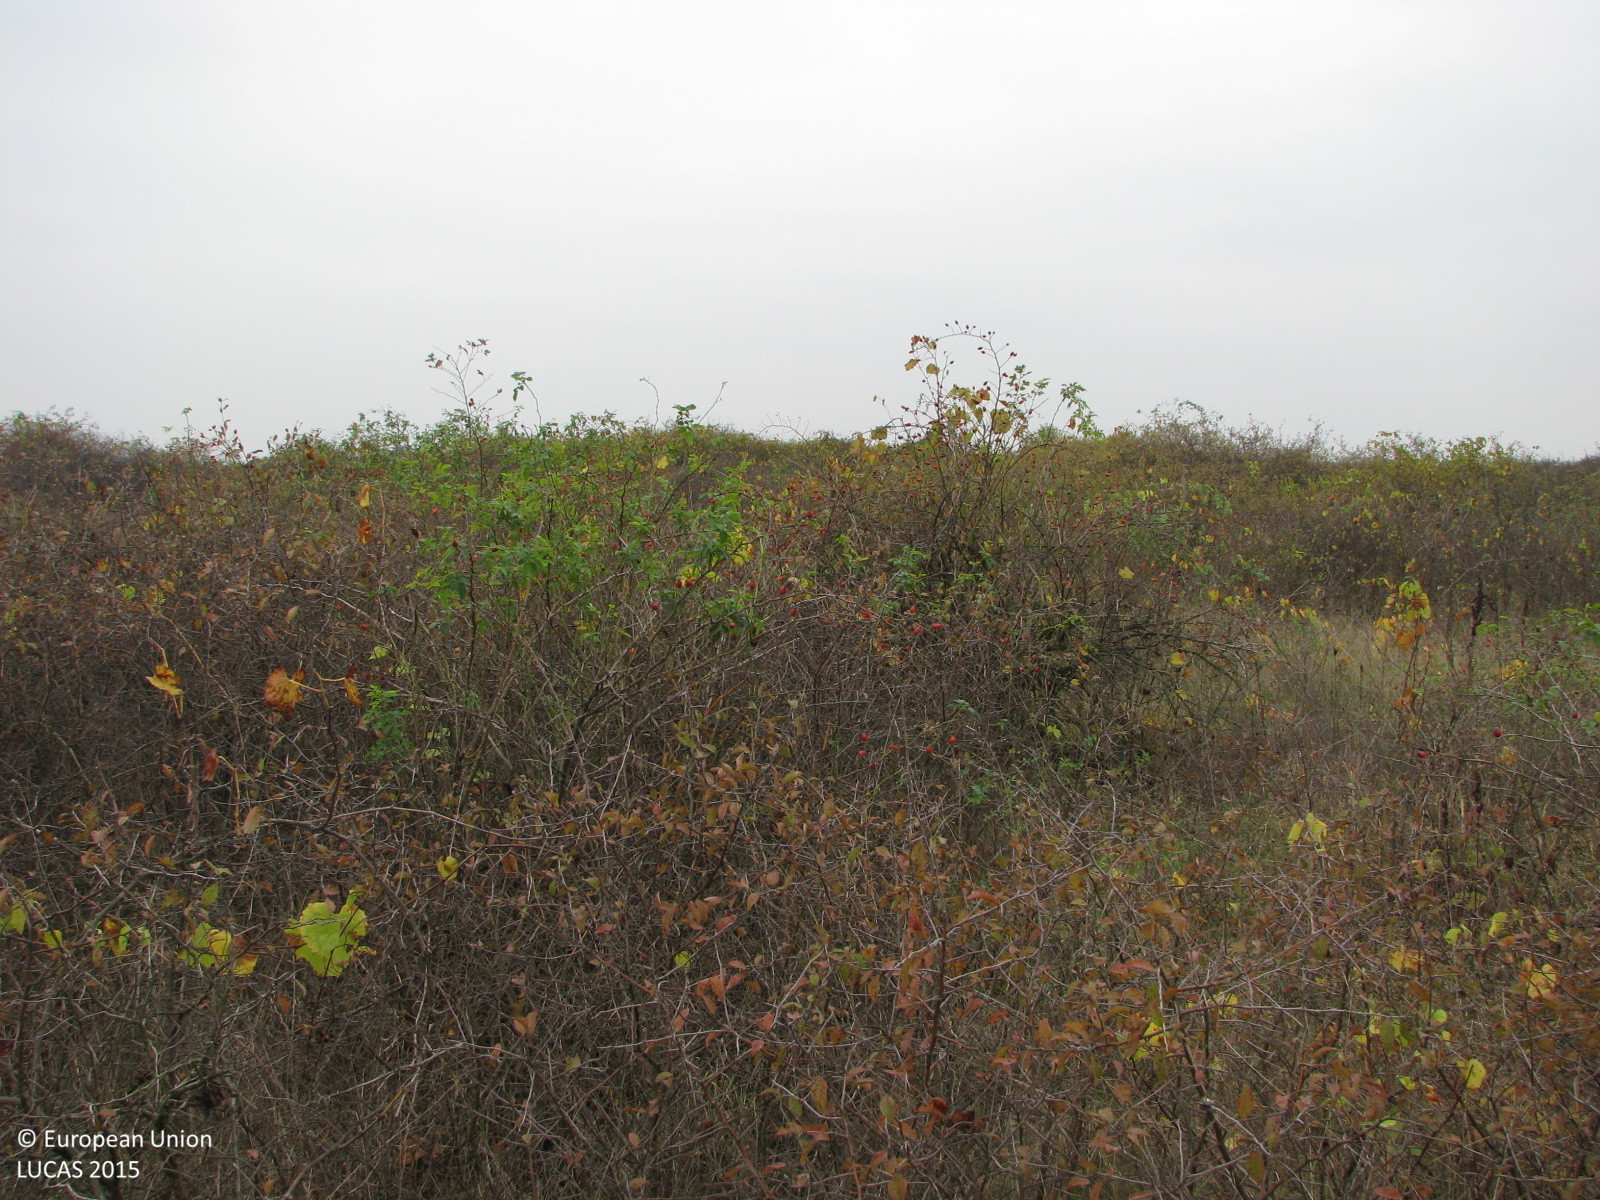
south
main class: Shrubland
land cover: Shrubland without tree cover
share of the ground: > 75 %
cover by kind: shrubs 80 %, herbaceous plants 20 %
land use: Semi-natural and natural areas not in use
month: October
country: BG
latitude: 42.5760
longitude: 26.7291
